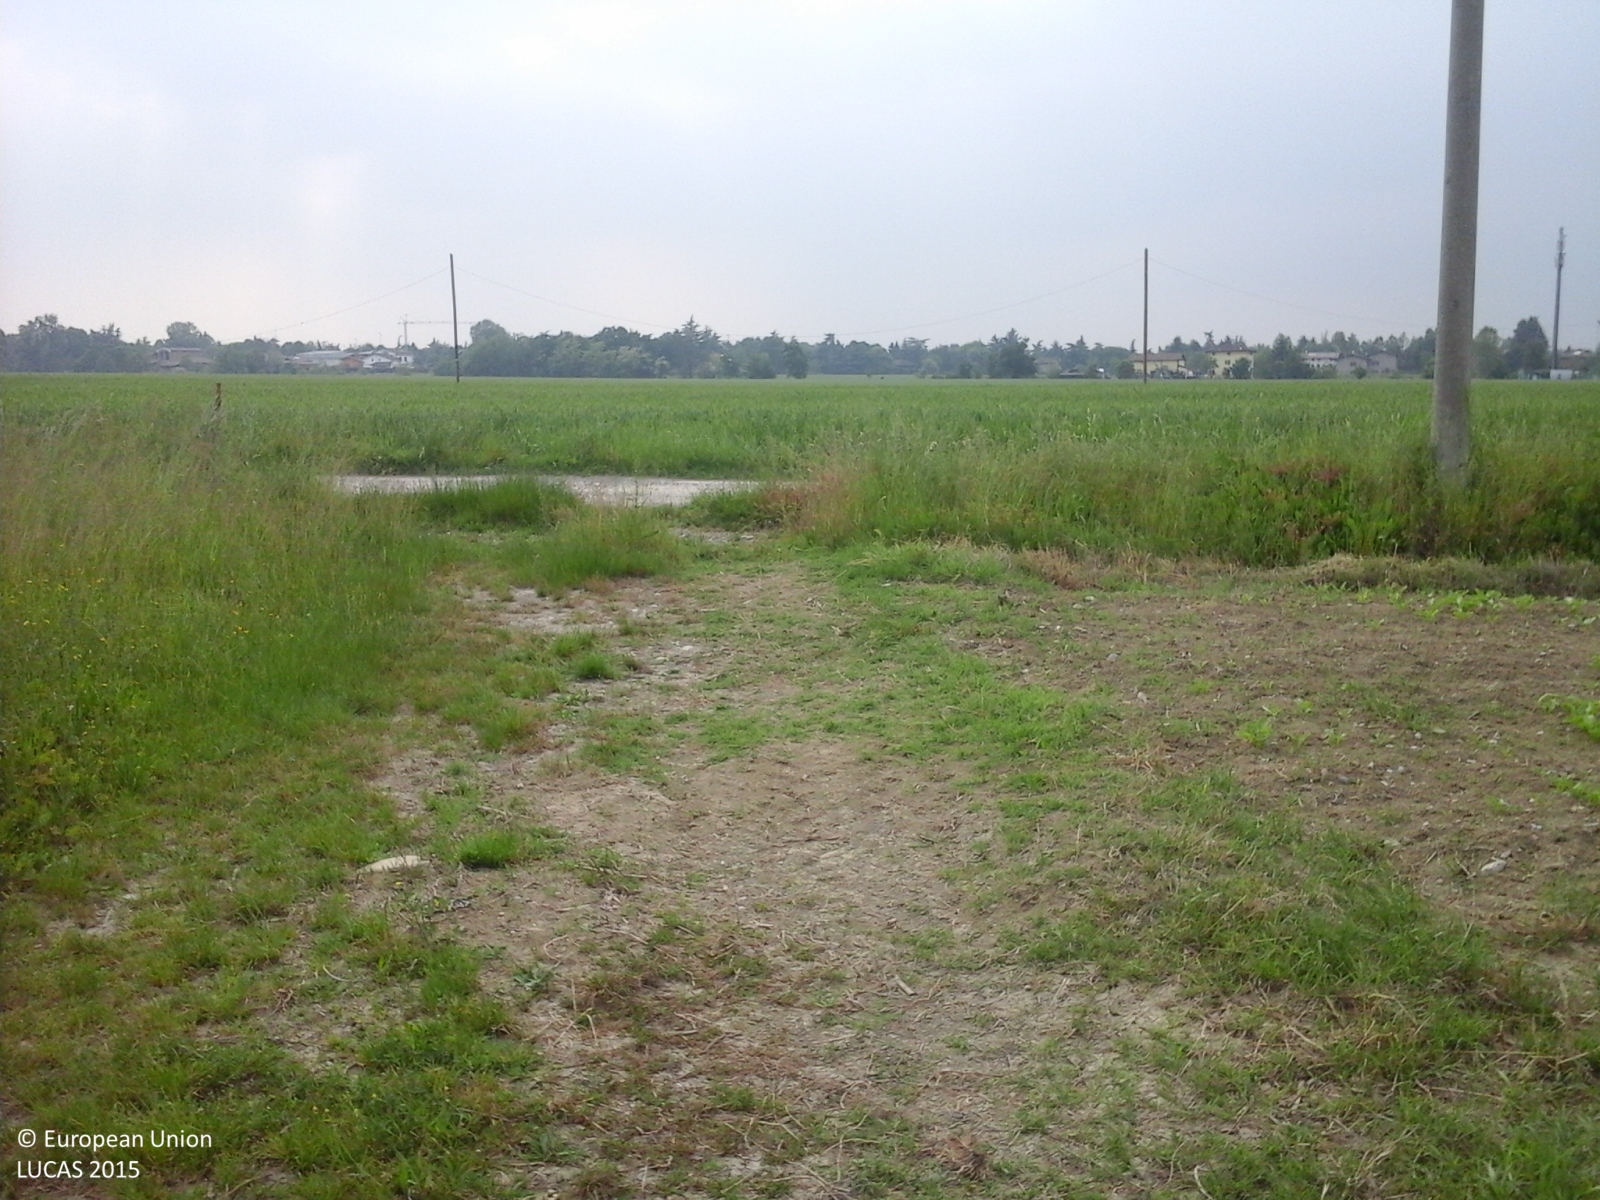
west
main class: Cropland
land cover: Sugar beet
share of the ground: 10 - 25 %
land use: Agriculture (excluding fallow land and kitchen gardens)
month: May
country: IT
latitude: 44.5629
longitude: 10.9171
